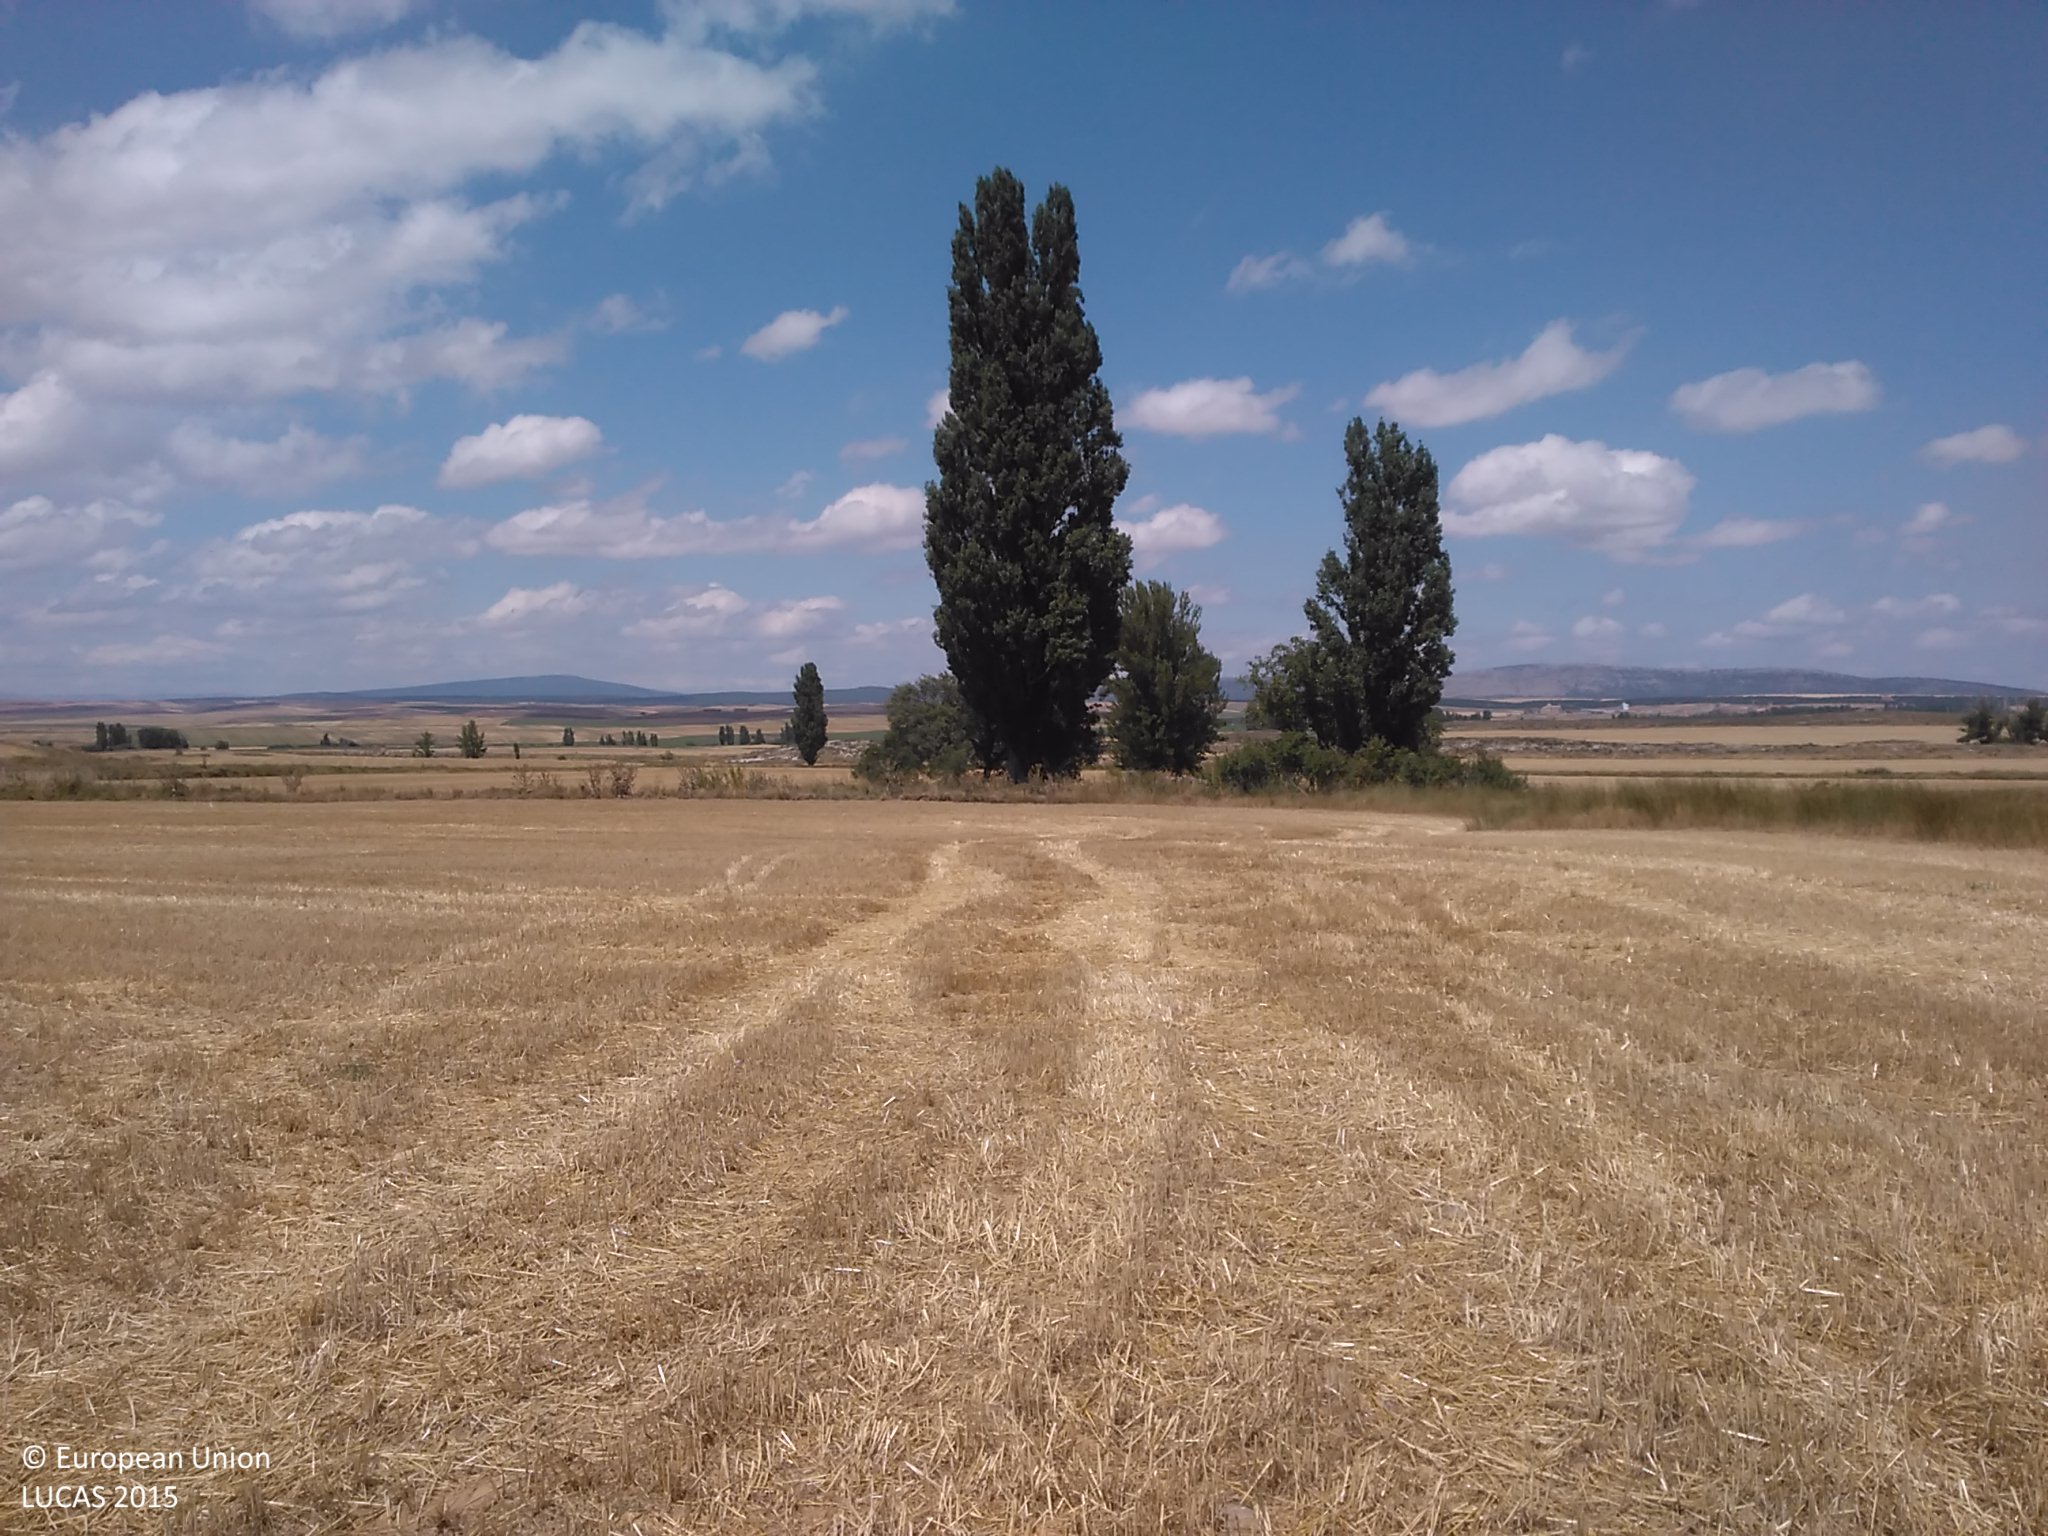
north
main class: Cropland
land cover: Common wheat
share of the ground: < 10 %
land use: Agriculture (excluding fallow land and kitchen gardens)
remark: Harvested field
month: July
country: ES
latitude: 41.6553
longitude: -2.2224
